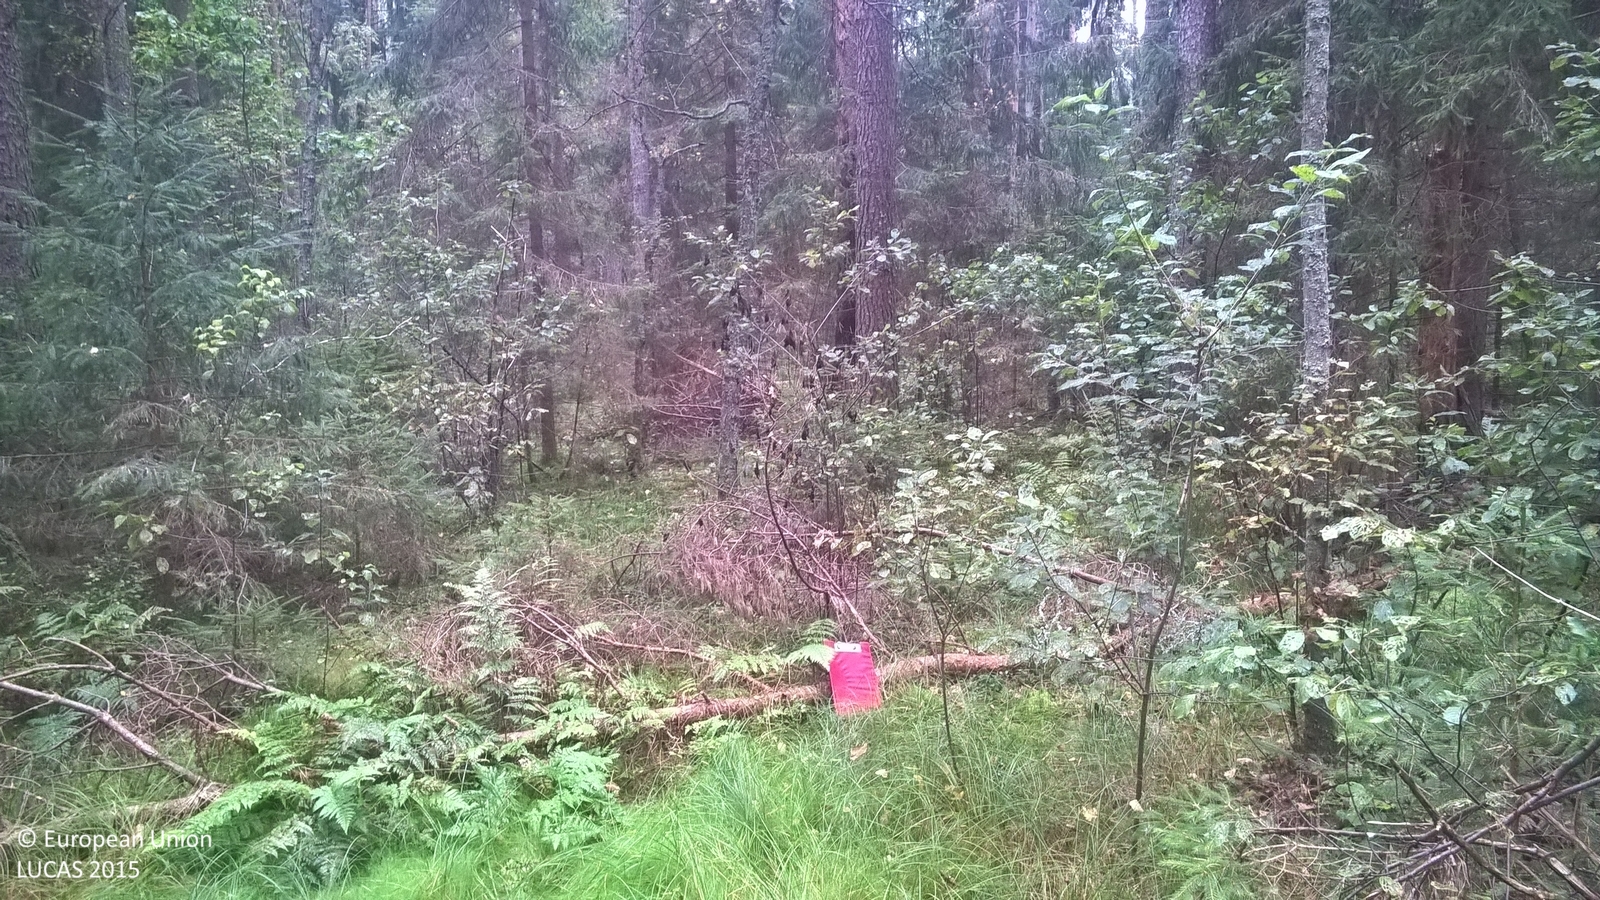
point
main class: Woodland
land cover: Other coniferous woodland
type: hemiboreal forest and nemoral coniferous forest and mixed broadleaved-coniferous forest
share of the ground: > 75 %
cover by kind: coniferous forest trees 75 %, broadleaved forest trees 10 %, herbaceous plants 10 %, shrubs 5 %
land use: Forestry
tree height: > 5 m
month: September
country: LV
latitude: 57.5172
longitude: 25.6280
